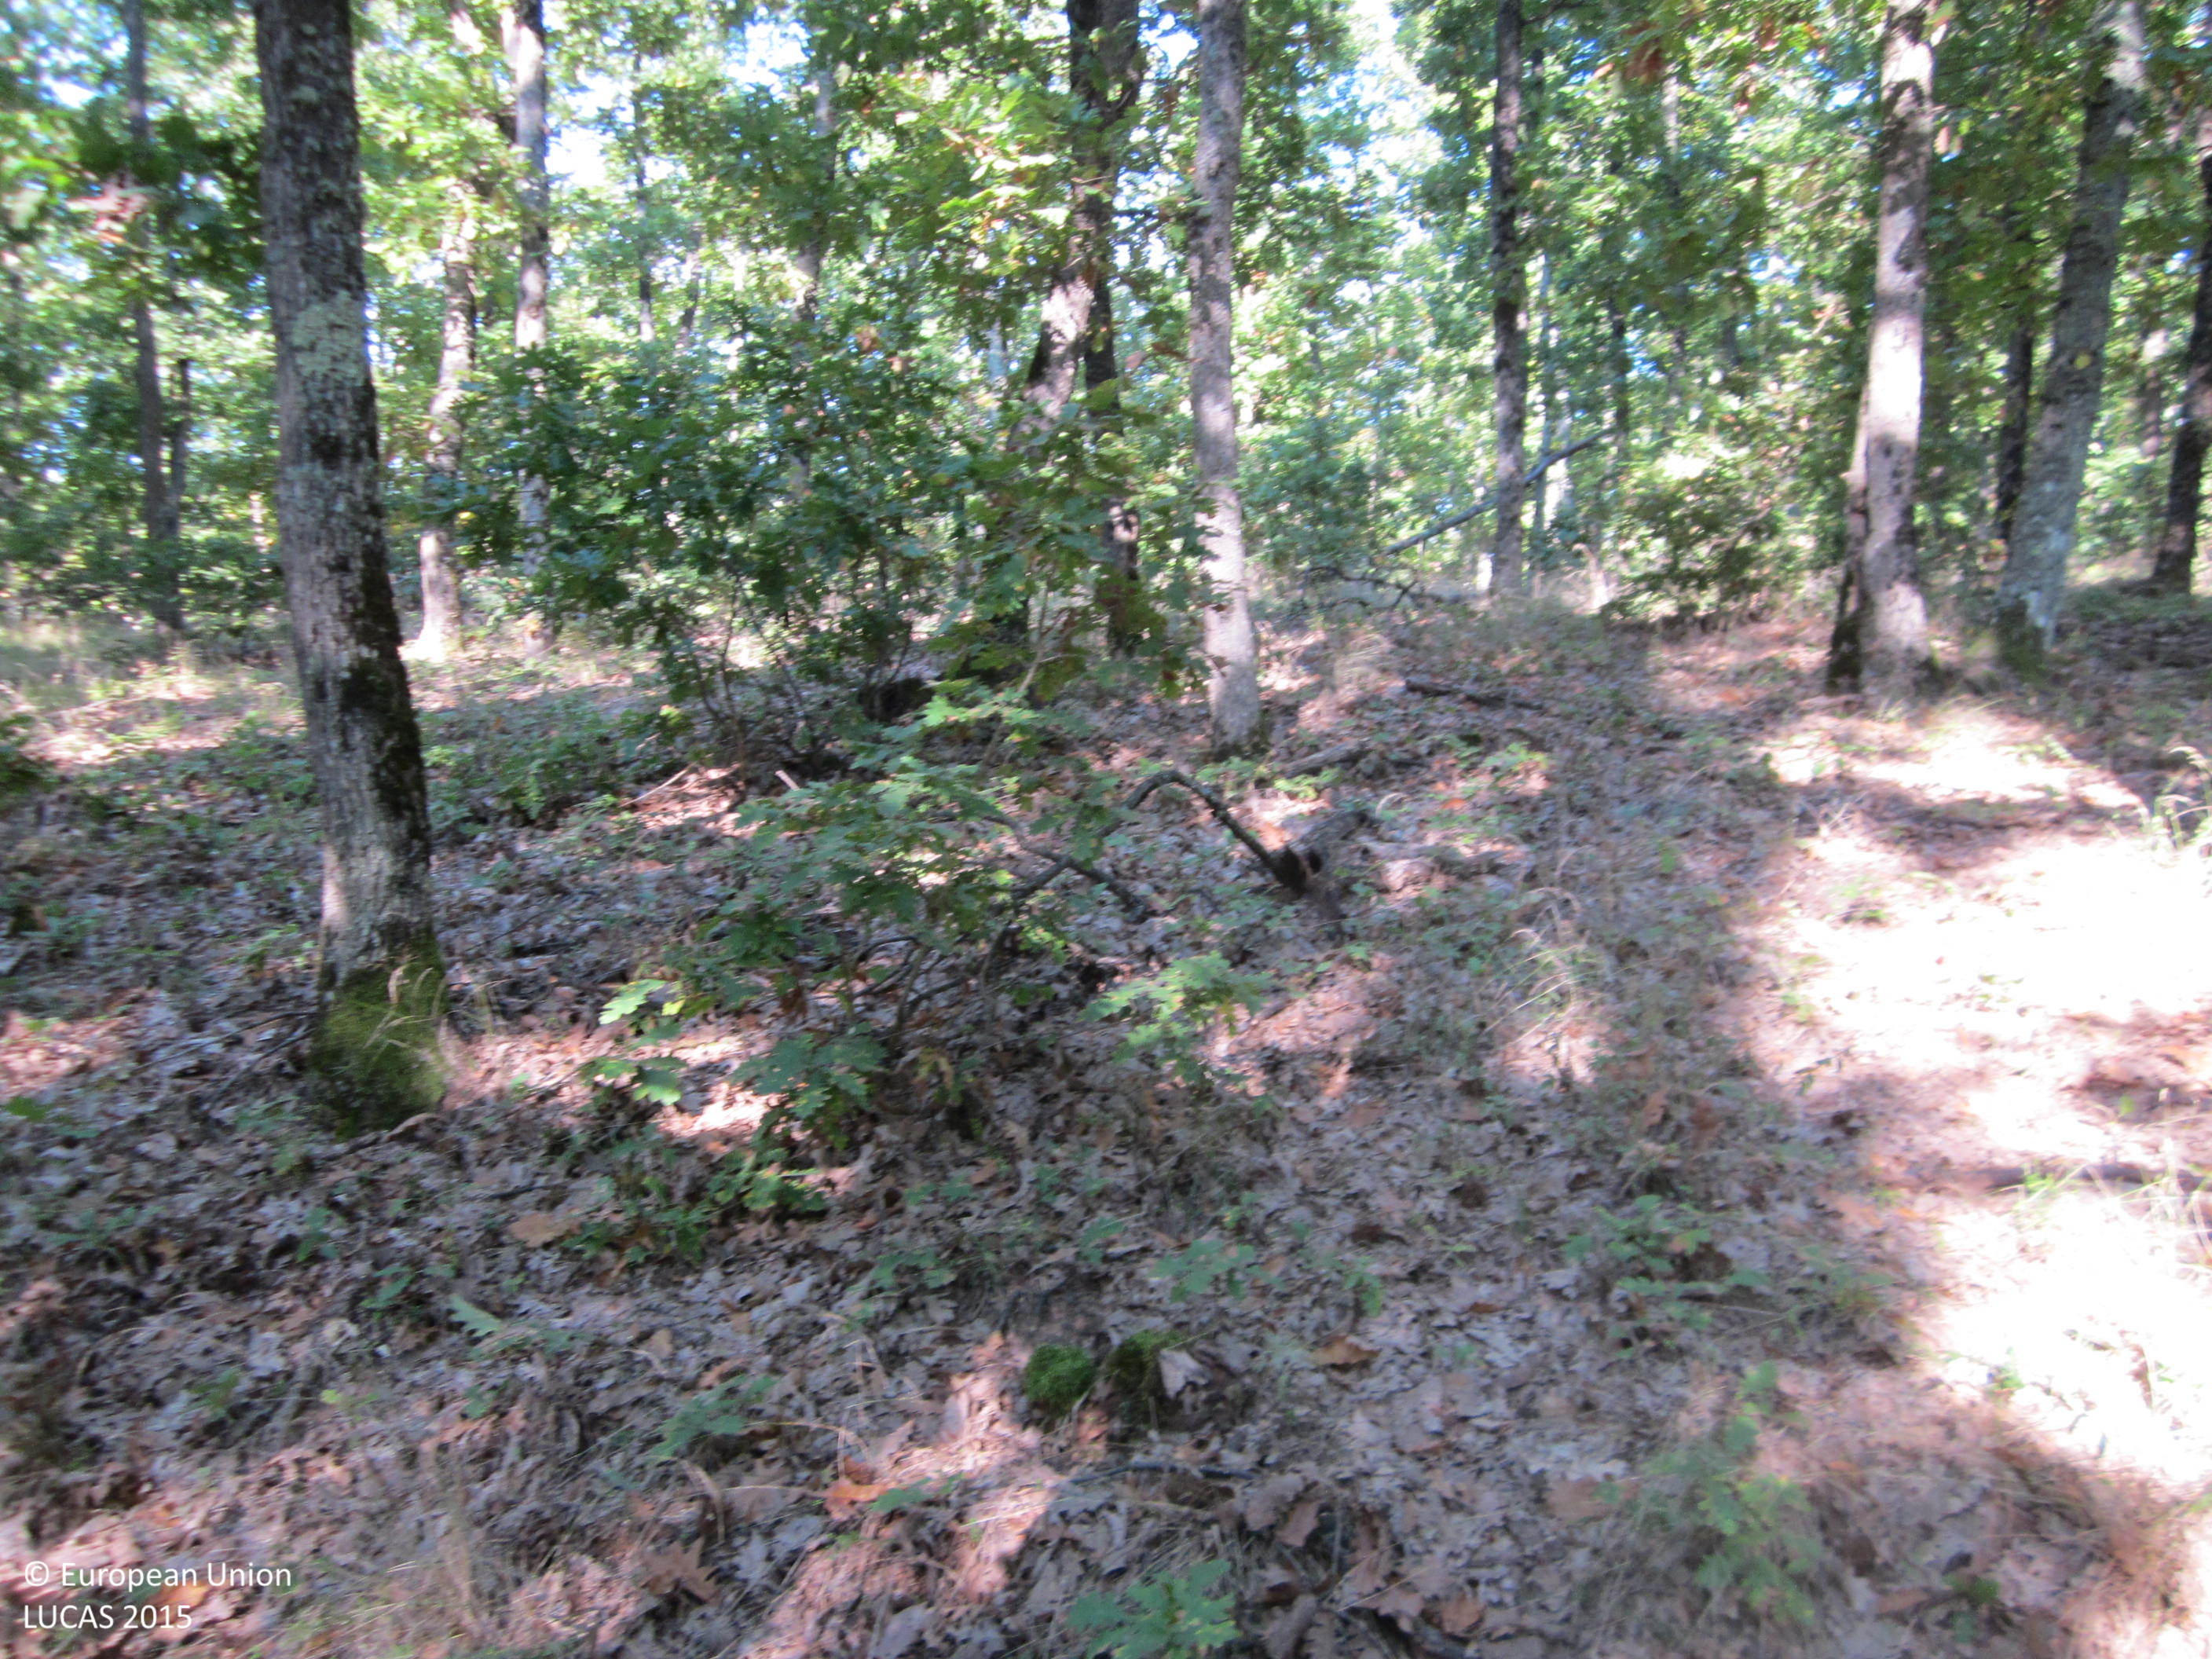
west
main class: Woodland
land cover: Broadleaved woodland
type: acidophilous oak and oak-birch forest
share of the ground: 50 - 75 %
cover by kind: broadleaved forest trees 70 %, unconsolidated bare surface 25 %, herbaceous plants 5 %
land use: Forestry
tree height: > 5 m
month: October
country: BG
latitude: 42.7891
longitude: 26.6649
